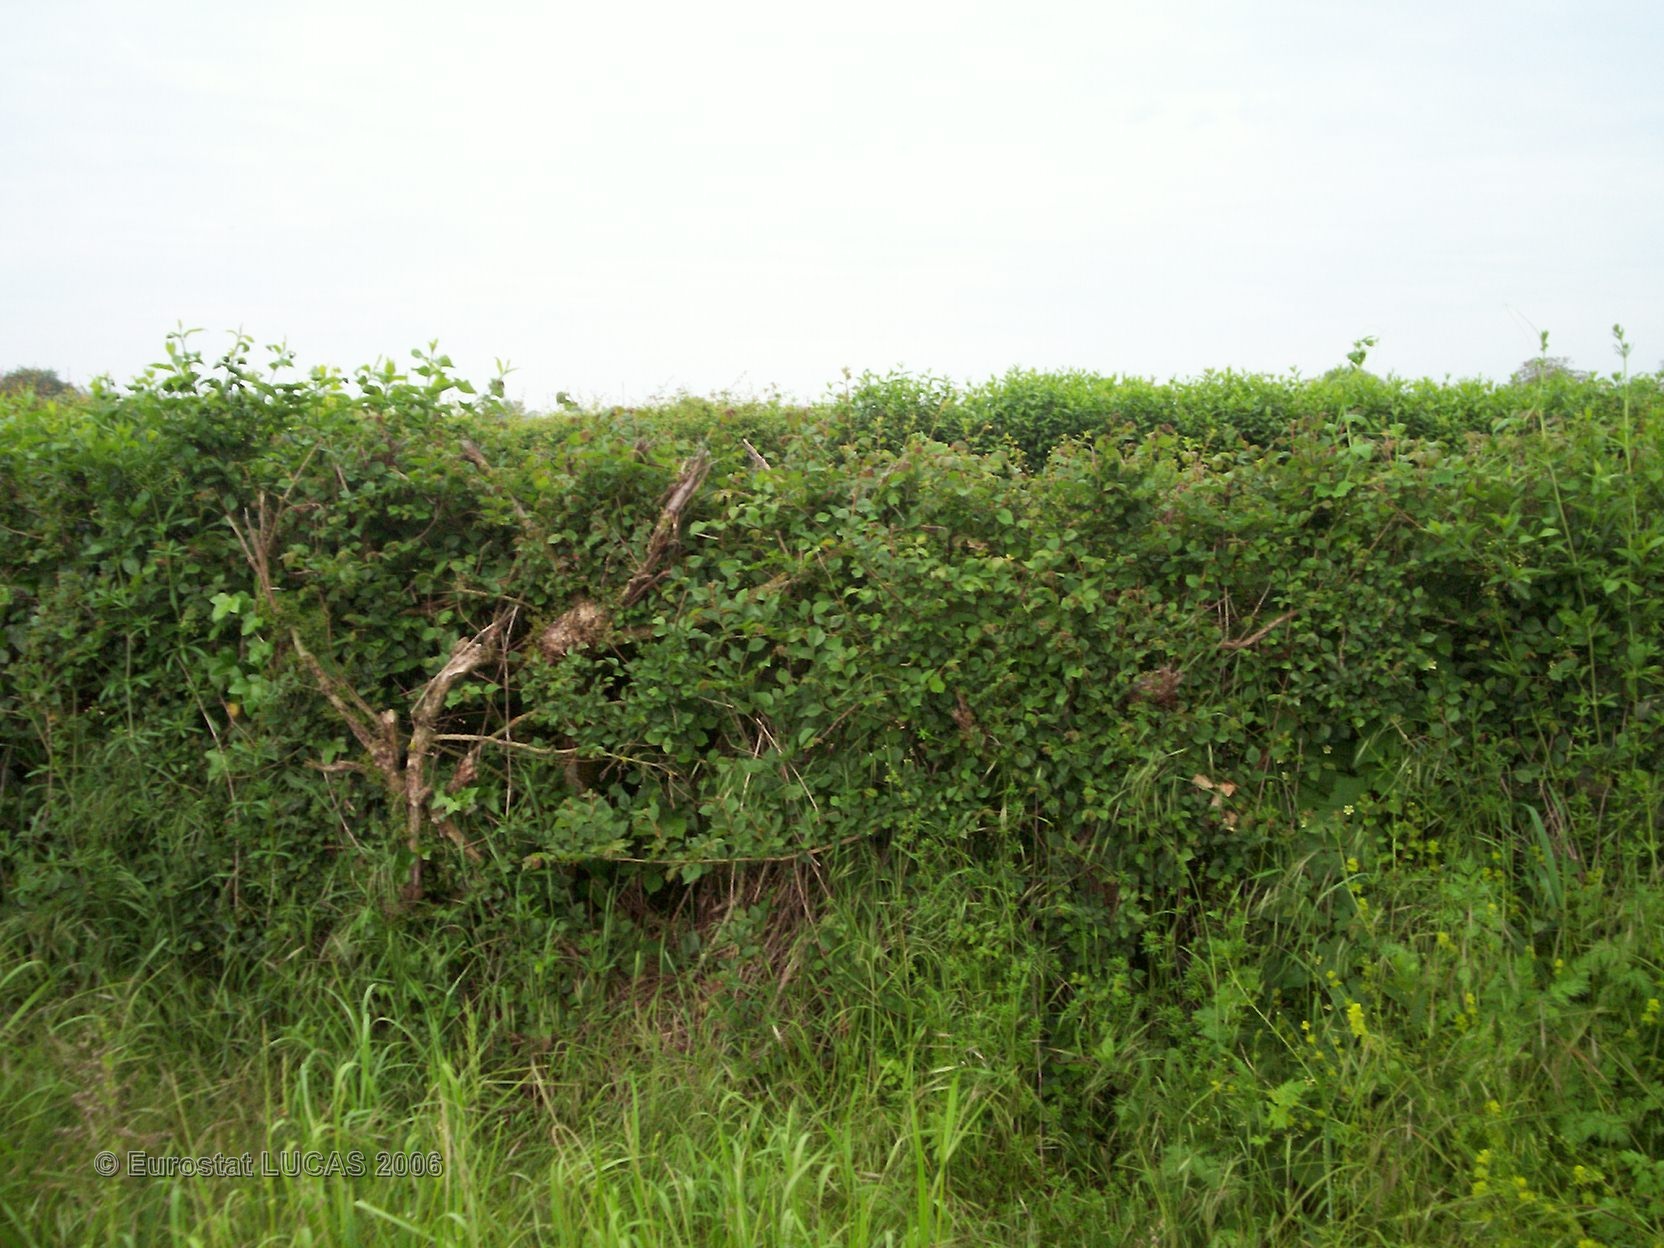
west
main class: Grassland
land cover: Grassland with sparse tree/shrub cover
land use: Agriculture (excluding fallow land and kitchen gardens)
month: May
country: FR
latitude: 46.6646
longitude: 1.0595
